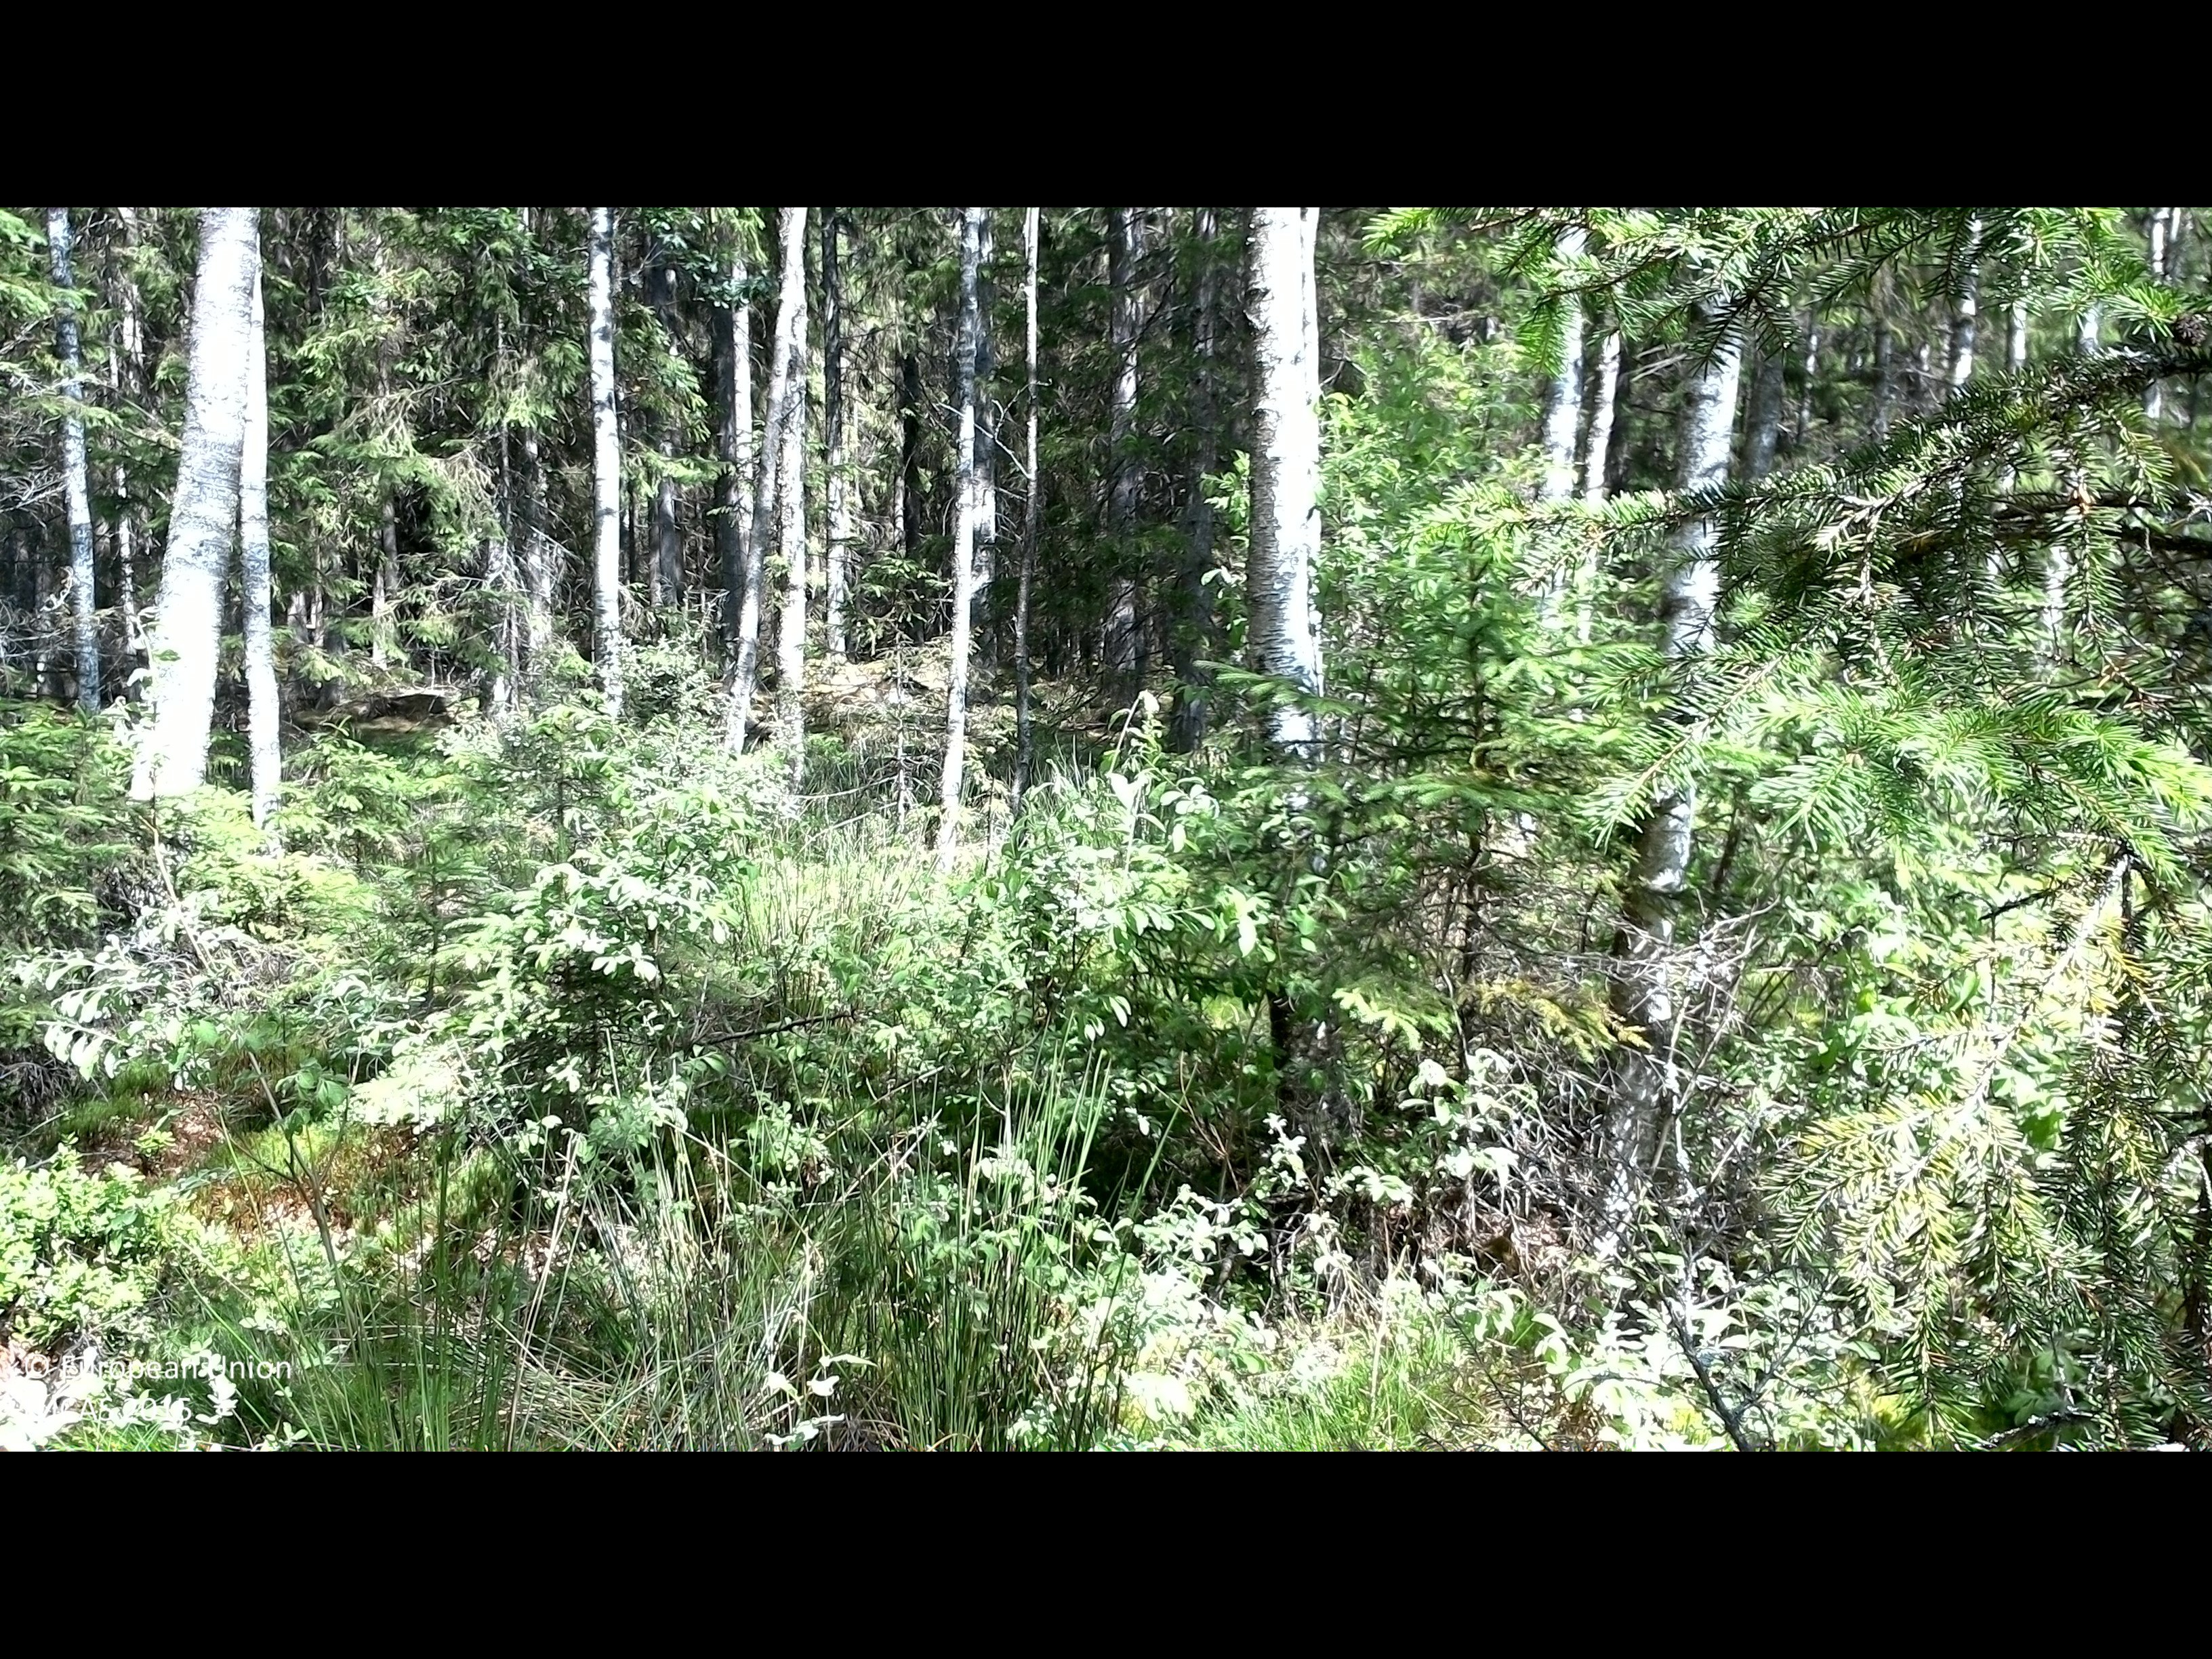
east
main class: Woodland
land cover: Broadleaved woodland
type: boreal forest
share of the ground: 50 - 75 %
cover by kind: broadleaved forest trees 50 %, lichens and mosses 25 %, coniferous forest trees 10 %, herbaceous plants 10 %, shrubs 5 %
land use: Forestry
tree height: > 5 m
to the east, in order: Broadleaved woodland; Spruce dominated coniferous woodland; Paved roads, cycling and walking lanes; Spruce dominated coniferous woodland; Ditches and canals; Spruce dominated coniferous woodland; Spruce dominated mixed woodland
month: July
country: SE
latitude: 56.4260
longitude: 15.1707
